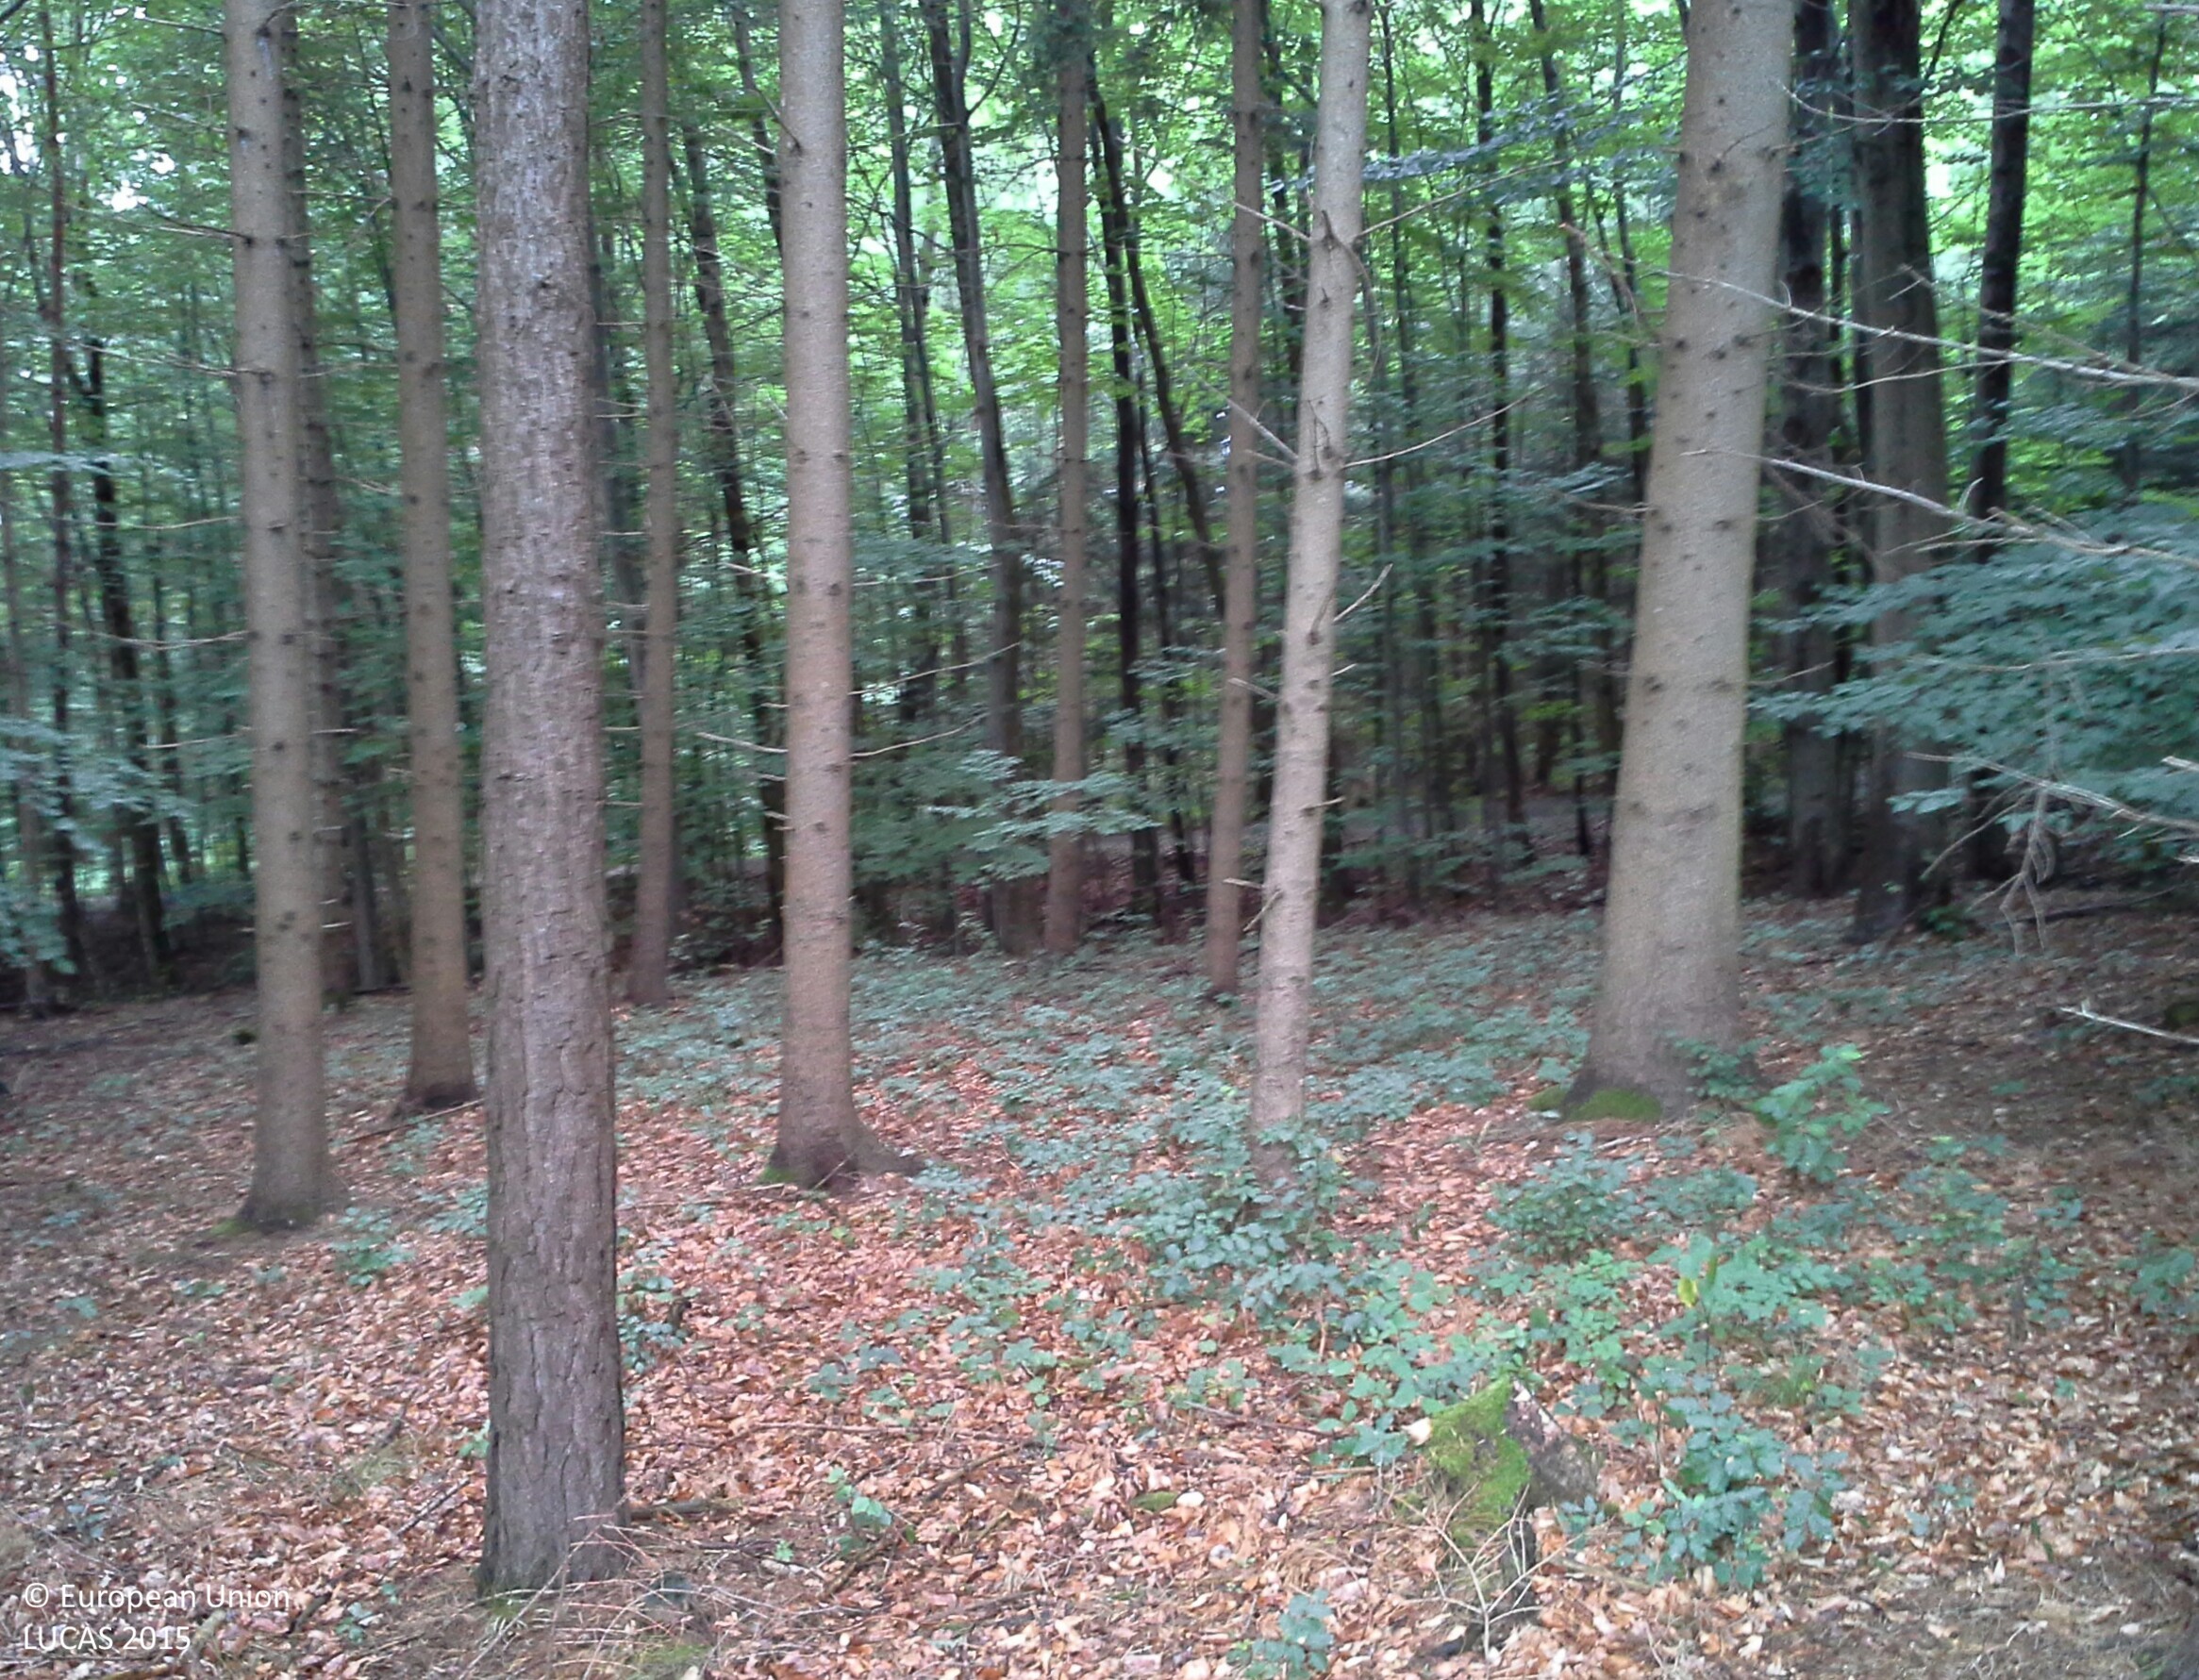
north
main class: Woodland
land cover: Spruce dominated mixed woodland
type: beech forest
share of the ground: > 75 %
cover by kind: coniferous forest trees 50 %, broadleaved forest trees 35 %, consolidated bare surface 10 %, herbaceous plants 5 %
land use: Forestry
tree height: > 5 m
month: July
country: AT
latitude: 48.0462
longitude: 14.8164
